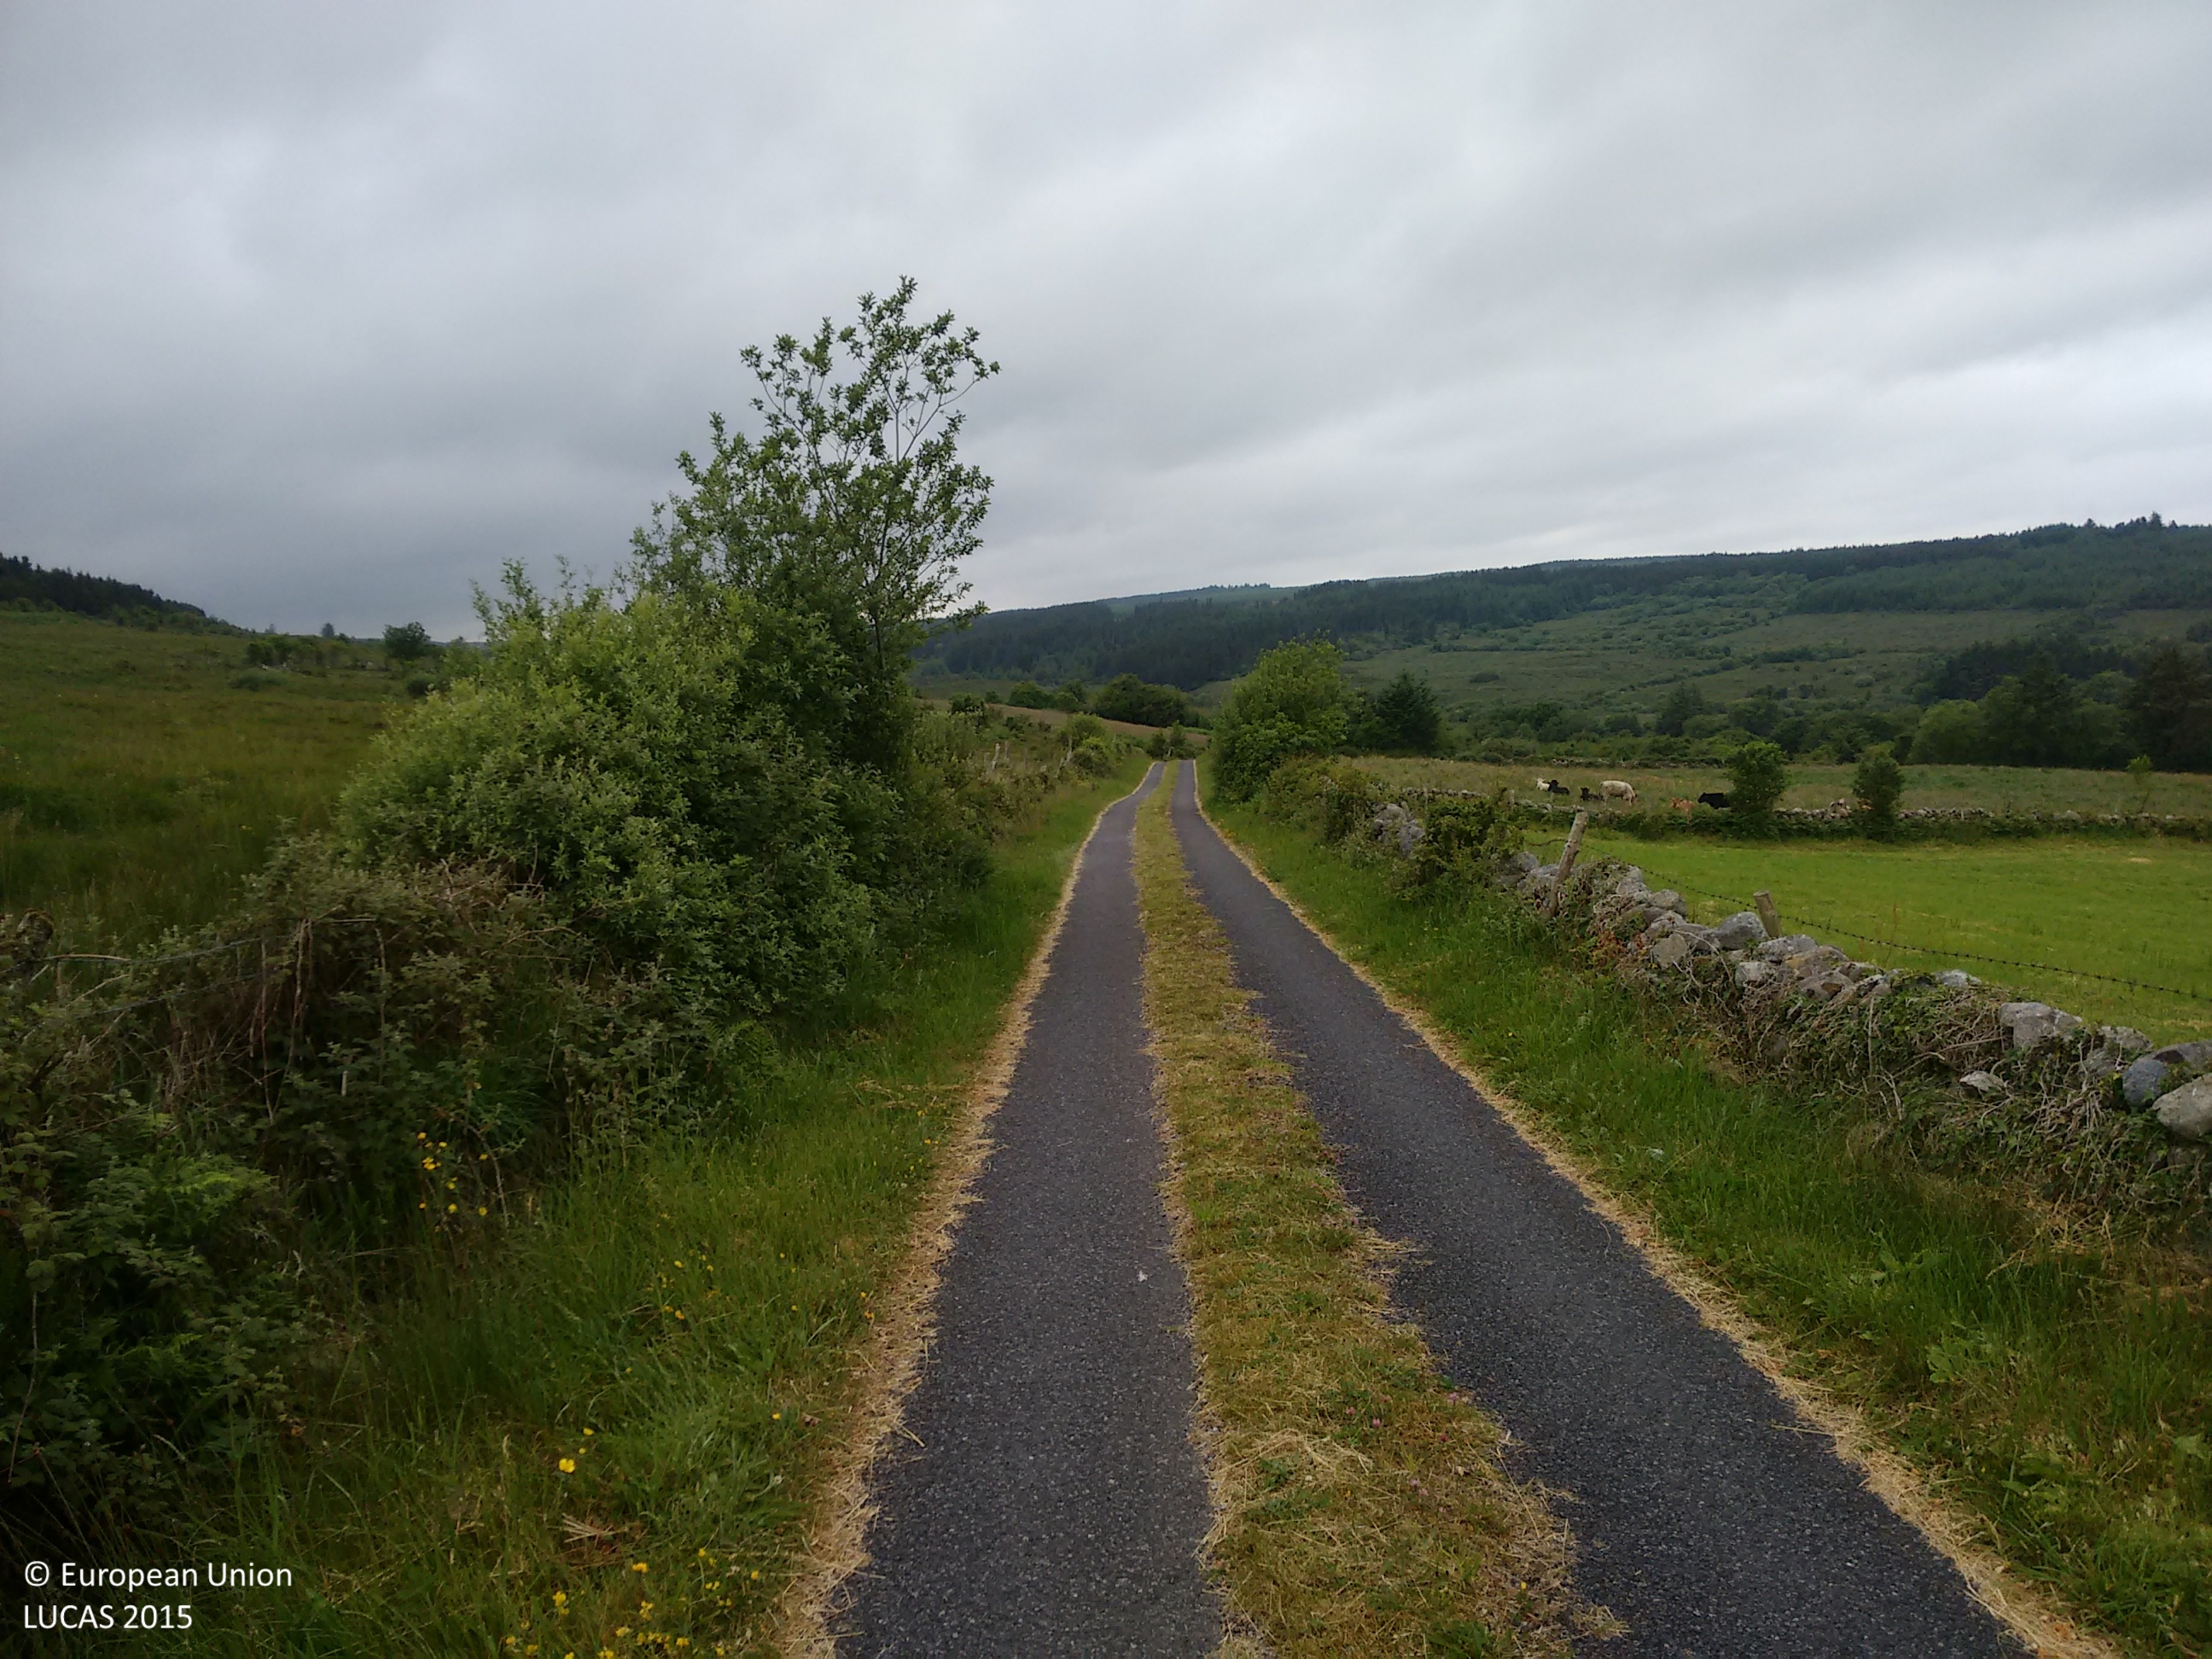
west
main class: Grassland
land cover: Grassland without tree/shrub cover
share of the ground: > 75 %
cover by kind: herbaceous plants 95 %, consolidated bare surface 5 %
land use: Agriculture (excluding fallow land and kitchen gardens)
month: June
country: IE
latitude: 53.1220
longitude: -8.4985
